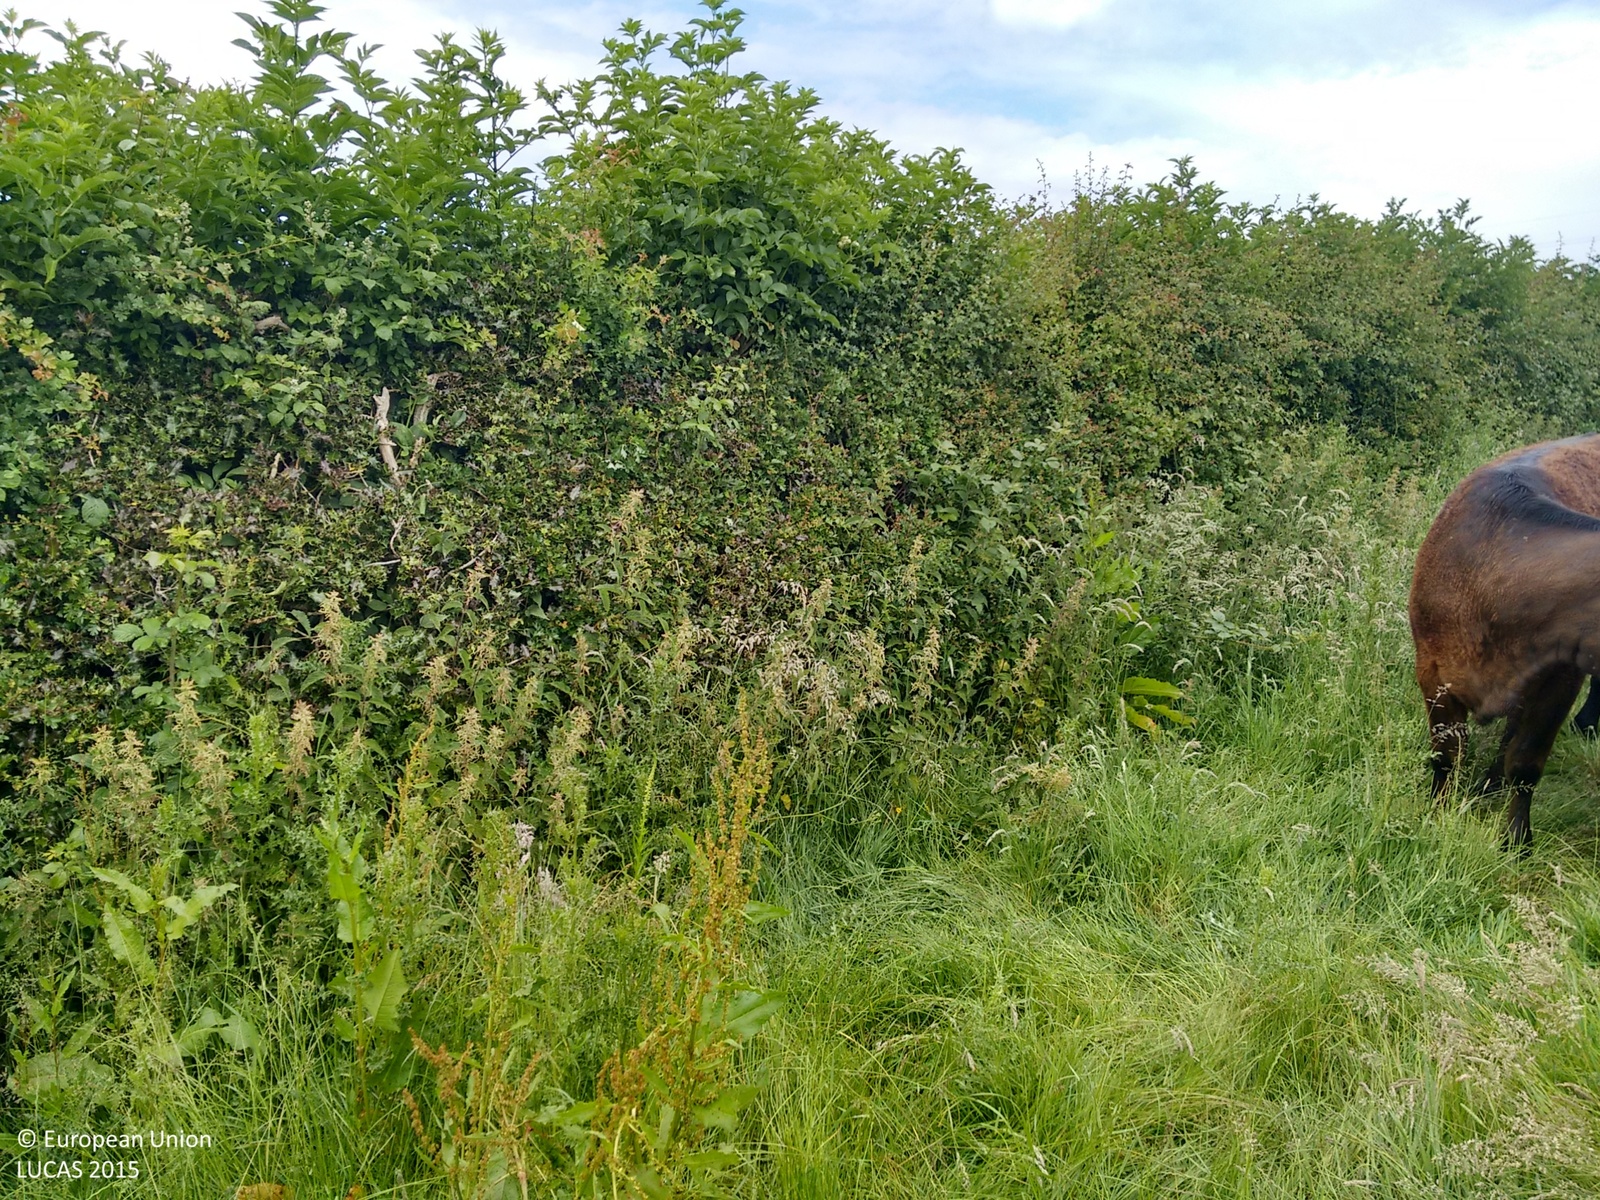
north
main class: Grassland
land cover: Grassland without tree/shrub cover
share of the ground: > 75 %
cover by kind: herbaceous plants 100 %
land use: Agriculture (excluding fallow land and kitchen gardens)
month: June
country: GB
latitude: 50.9273
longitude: 0.2812
